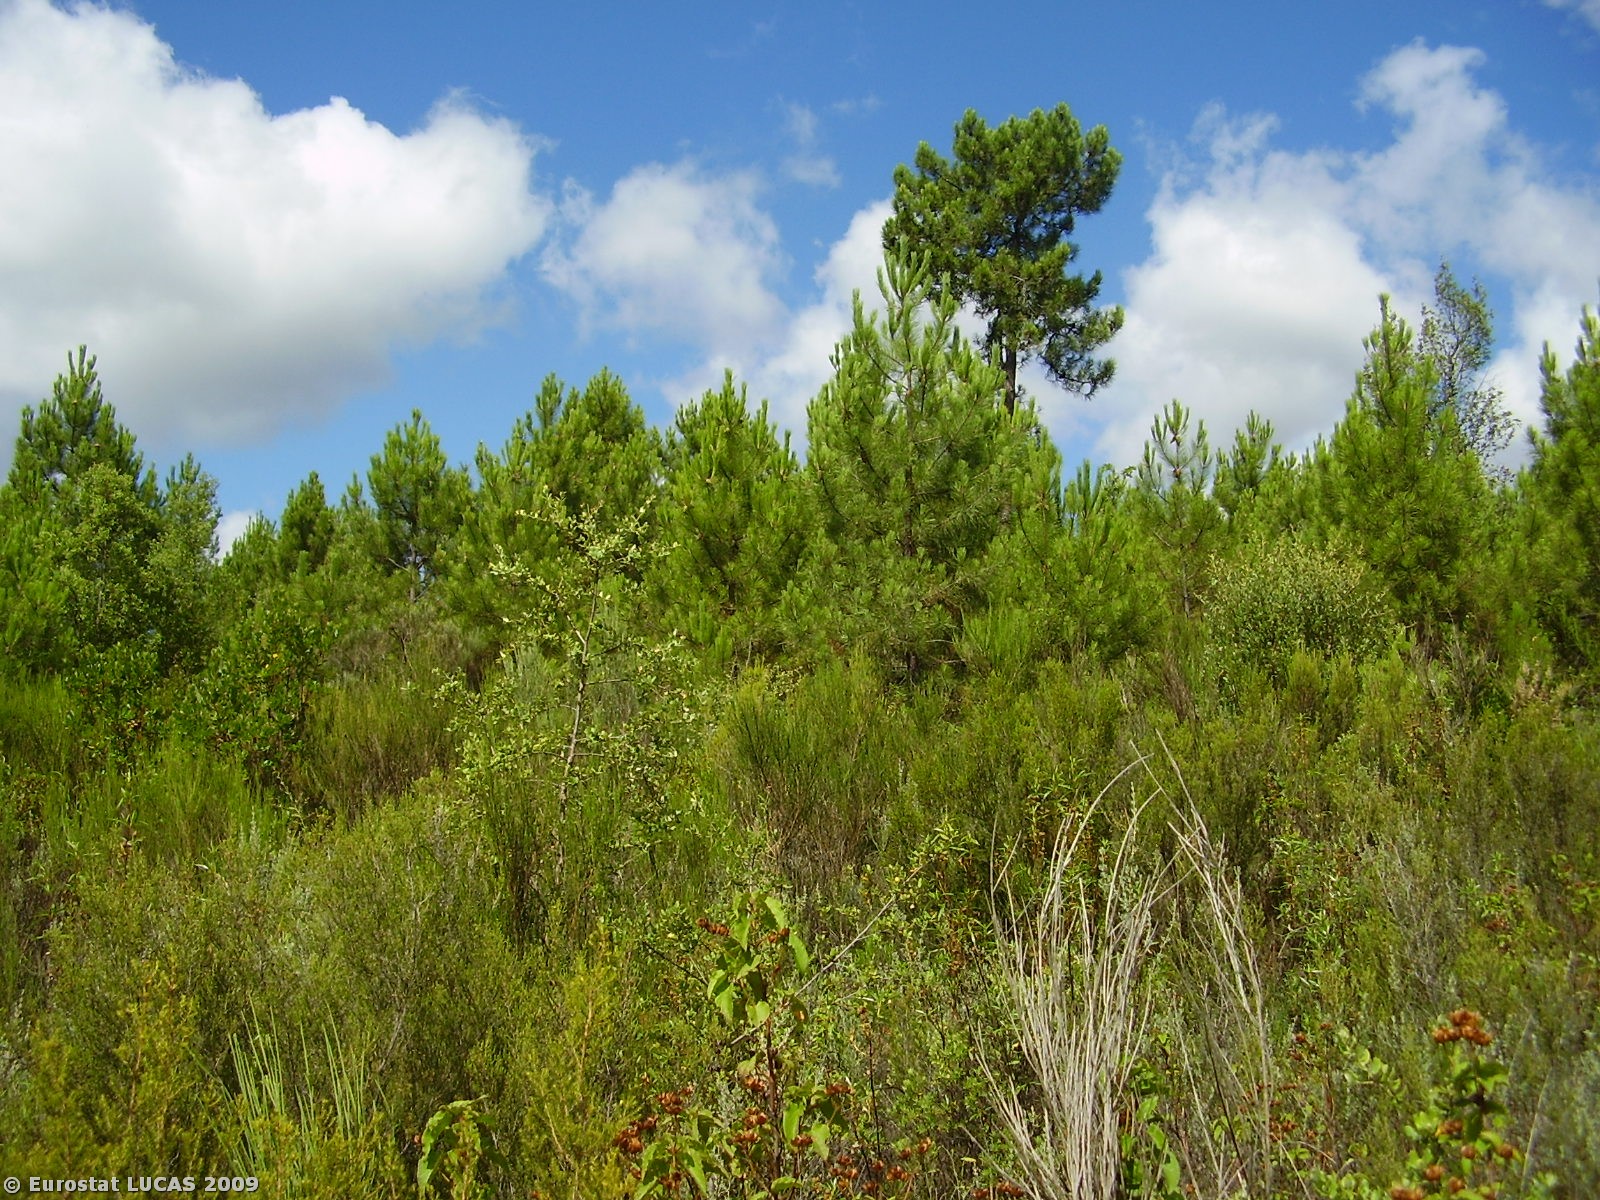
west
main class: Shrubland
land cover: Shrubland with sparse tree cover
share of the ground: > 75 %
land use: Unused
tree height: > 5 m
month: July
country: PT
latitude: 41.5986
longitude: -7.5877
